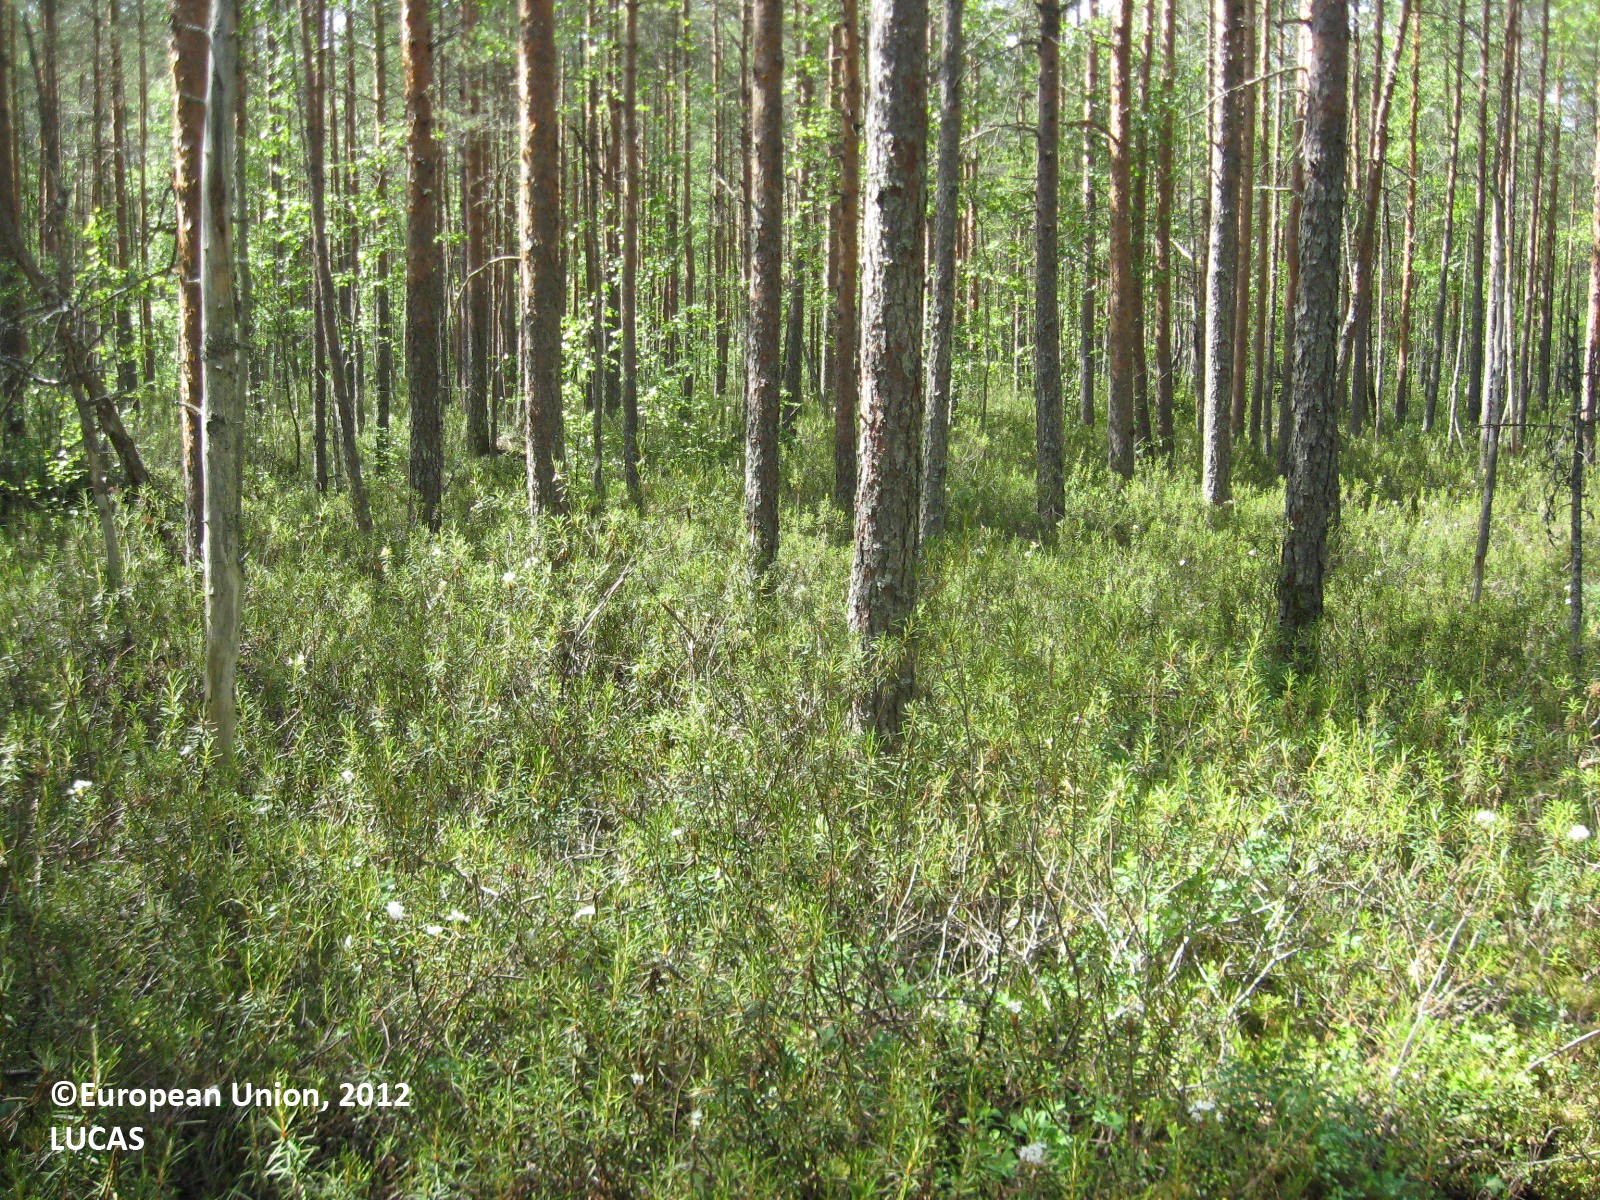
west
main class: Woodland
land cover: Spruce dominated coniferous woodland
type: boreal forest
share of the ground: > 75 %
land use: Forestry
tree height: > 5 m
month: June
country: FI
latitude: 62.7814
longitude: 22.5374
